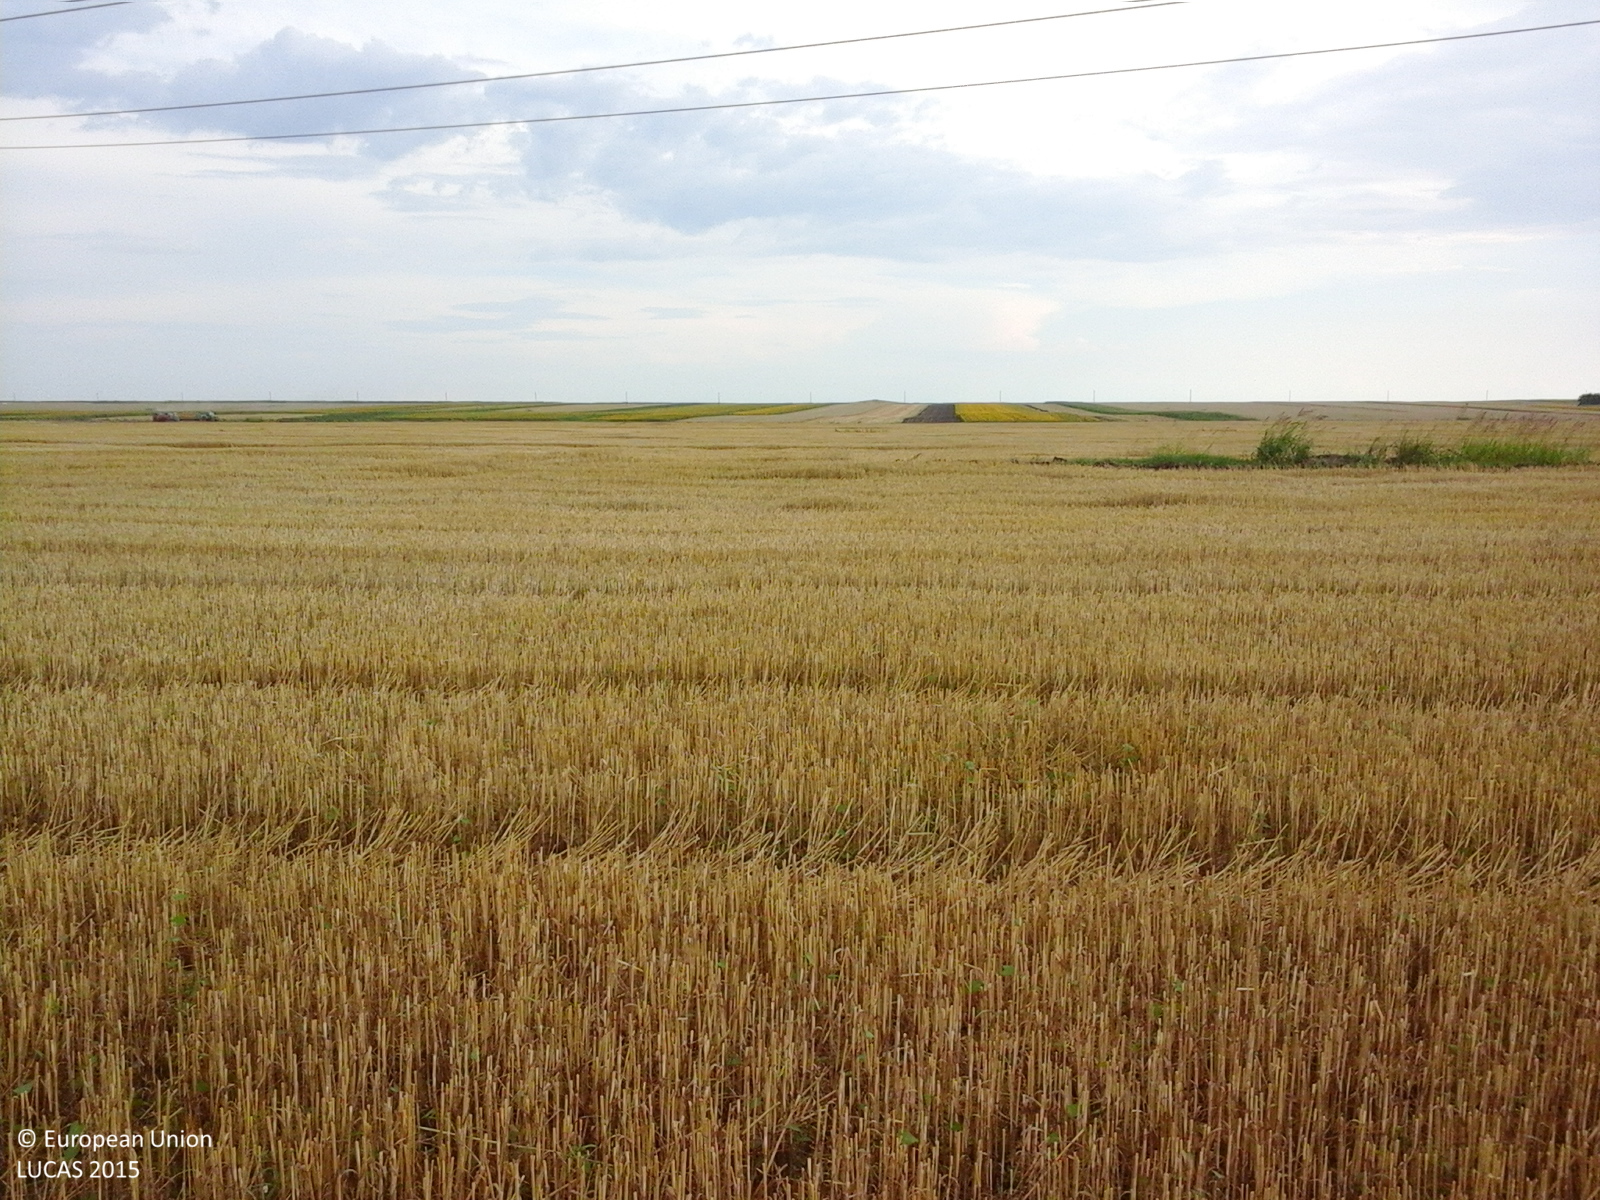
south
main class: Cropland
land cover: Common wheat
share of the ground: < 10 %
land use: Agriculture (excluding fallow land and kitchen gardens)
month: July
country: RO
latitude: 43.8941
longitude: 24.4934
